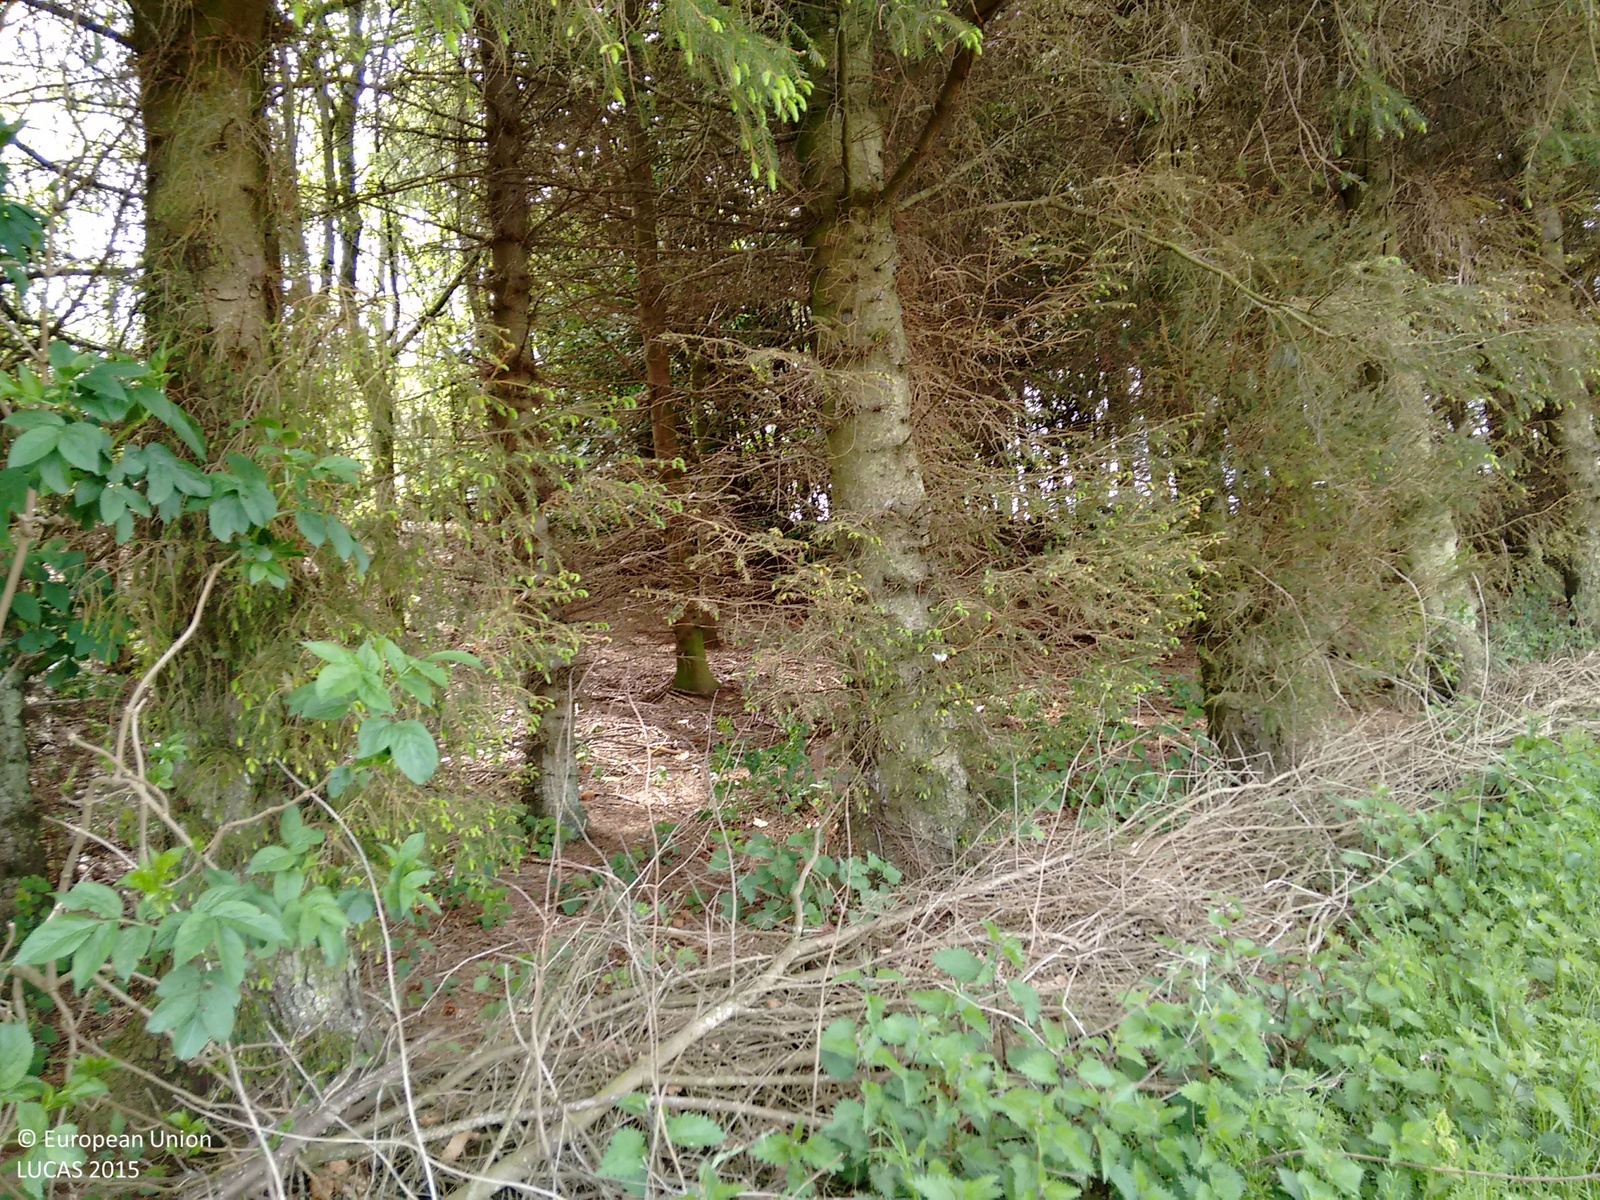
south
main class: Cropland
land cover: Dry pulses
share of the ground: < 10 %
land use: Agriculture (excluding fallow land and kitchen gardens)
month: May
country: GB
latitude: 55.7914
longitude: -2.3218
